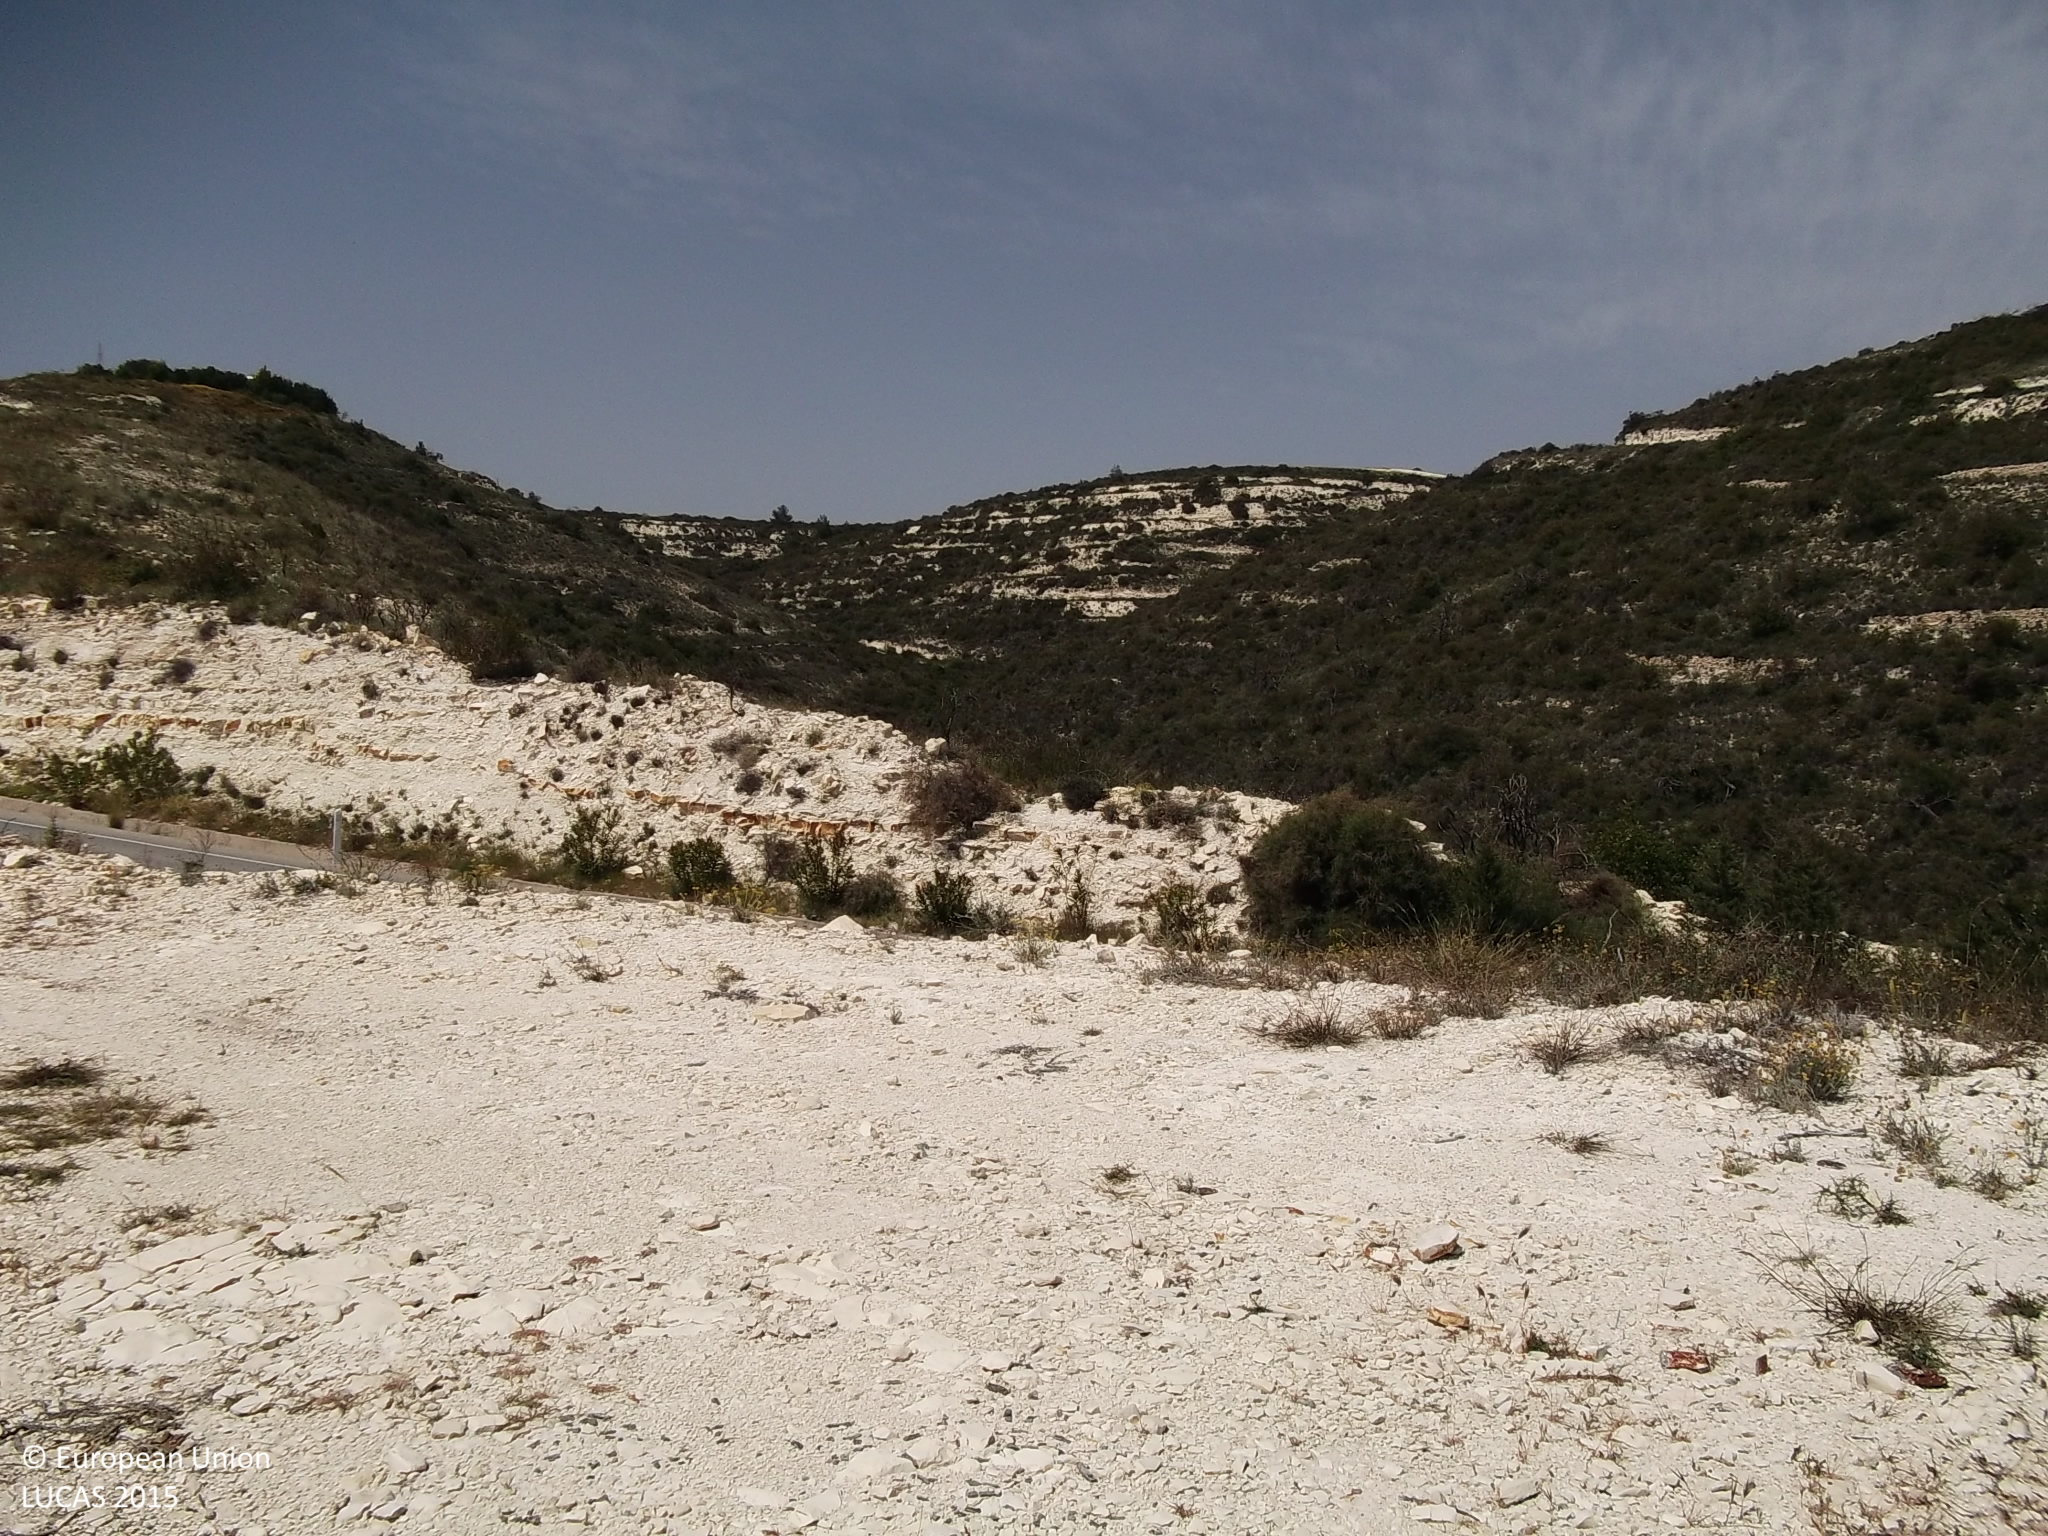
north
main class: Grassland
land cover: Spontaneously vegetated surfaces
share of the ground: 50 - 75 %
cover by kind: herbaceous plants 60 %, unconsolidated bare surface 40 %
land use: Semi-natural and natural areas not in use
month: April
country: CY
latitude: 34.8398
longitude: 33.3320
